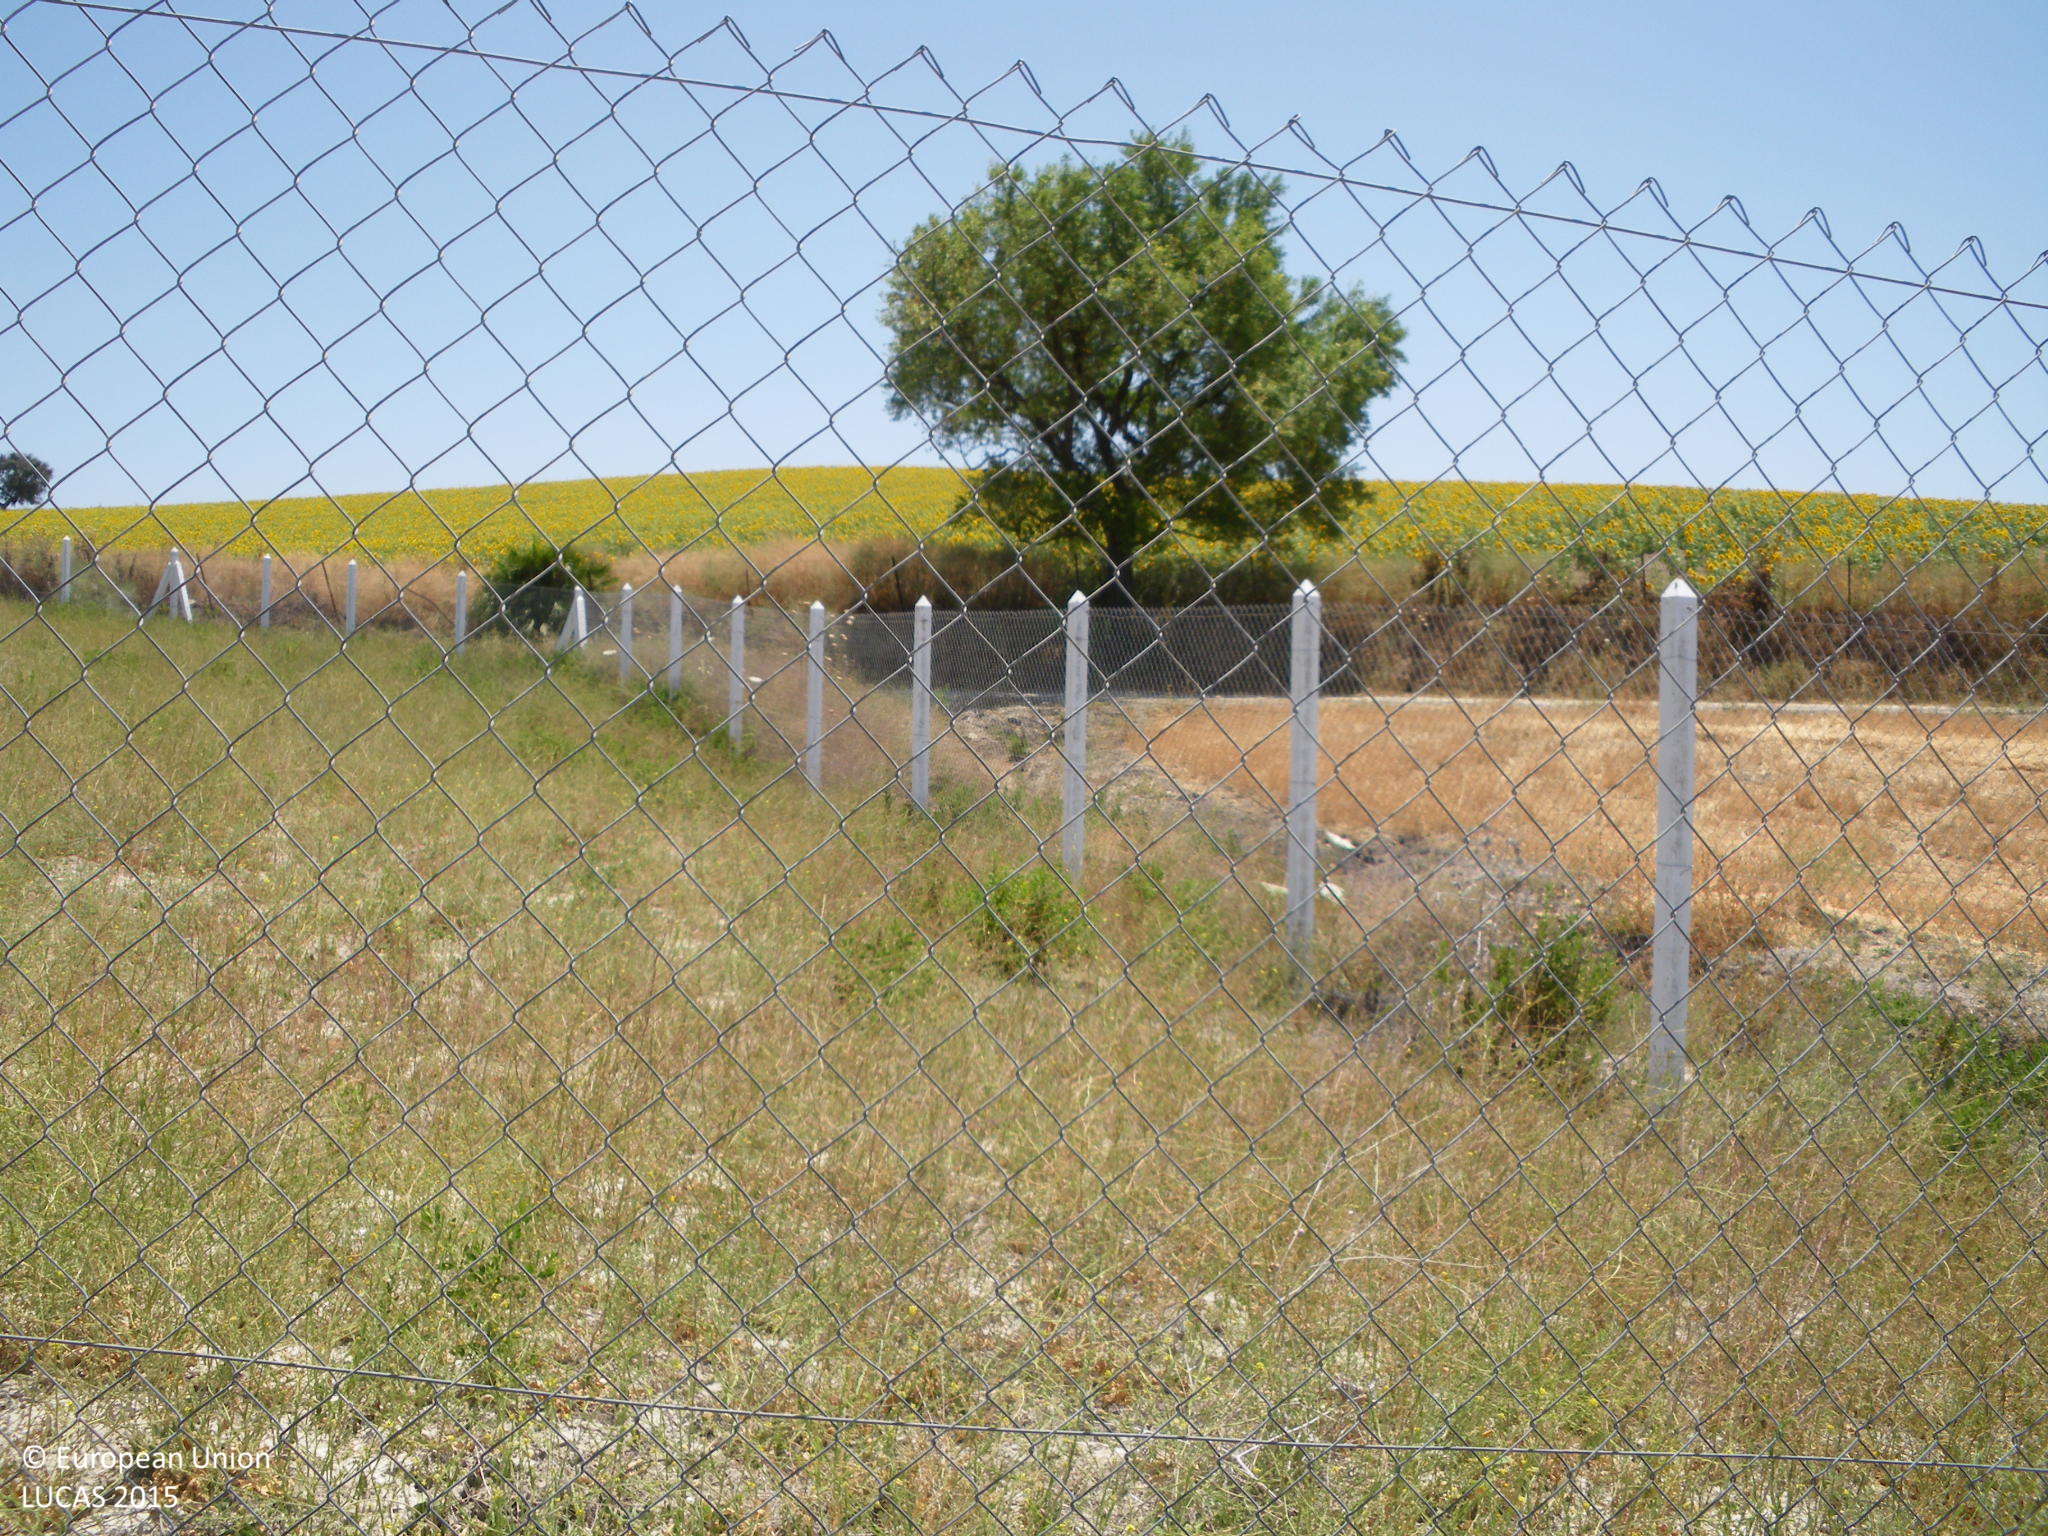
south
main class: Grassland
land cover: Spontaneously vegetated surfaces
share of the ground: > 75 %
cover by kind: herbaceous plants 90 %, unconsolidated bare surface 10 %
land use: Fallow land
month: June
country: ES
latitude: 36.8454
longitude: -5.9936
